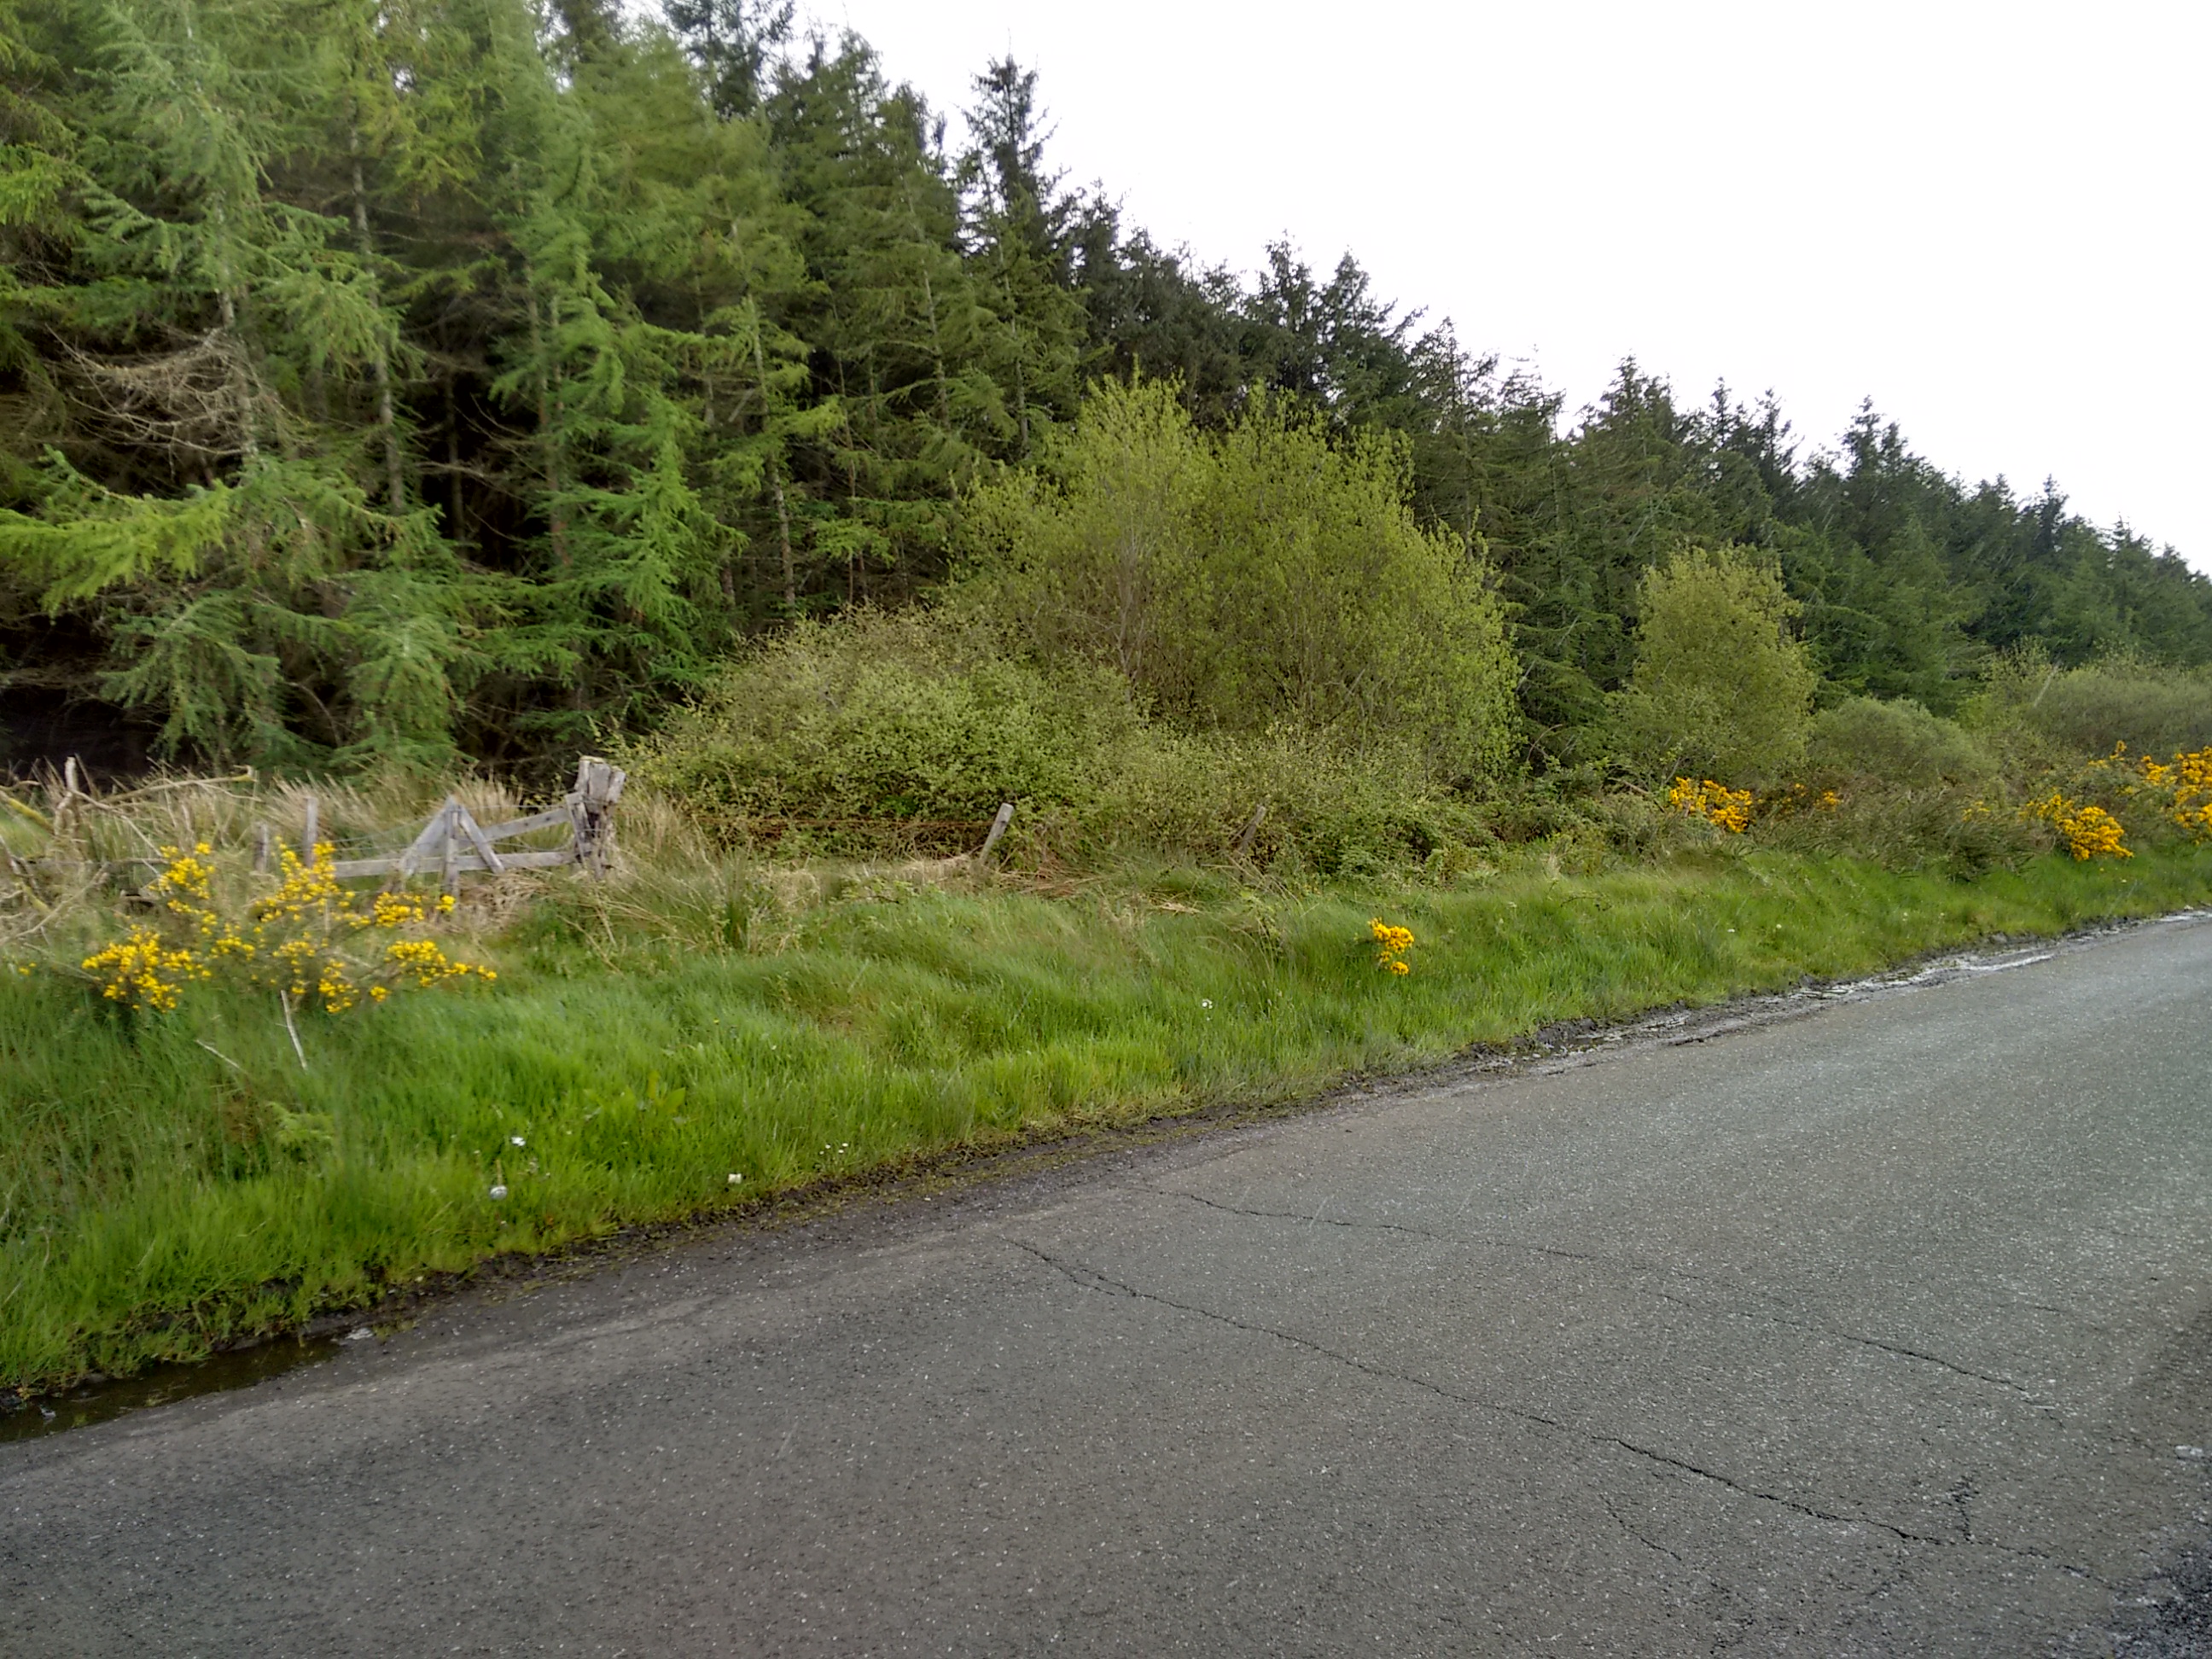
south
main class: Grassland
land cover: Grassland without tree/shrub cover
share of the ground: > 75 %
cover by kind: herbaceous plants 100 %
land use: Agriculture (excluding fallow land and kitchen gardens)
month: May
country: GB
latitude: 54.9683
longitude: -7.1215
